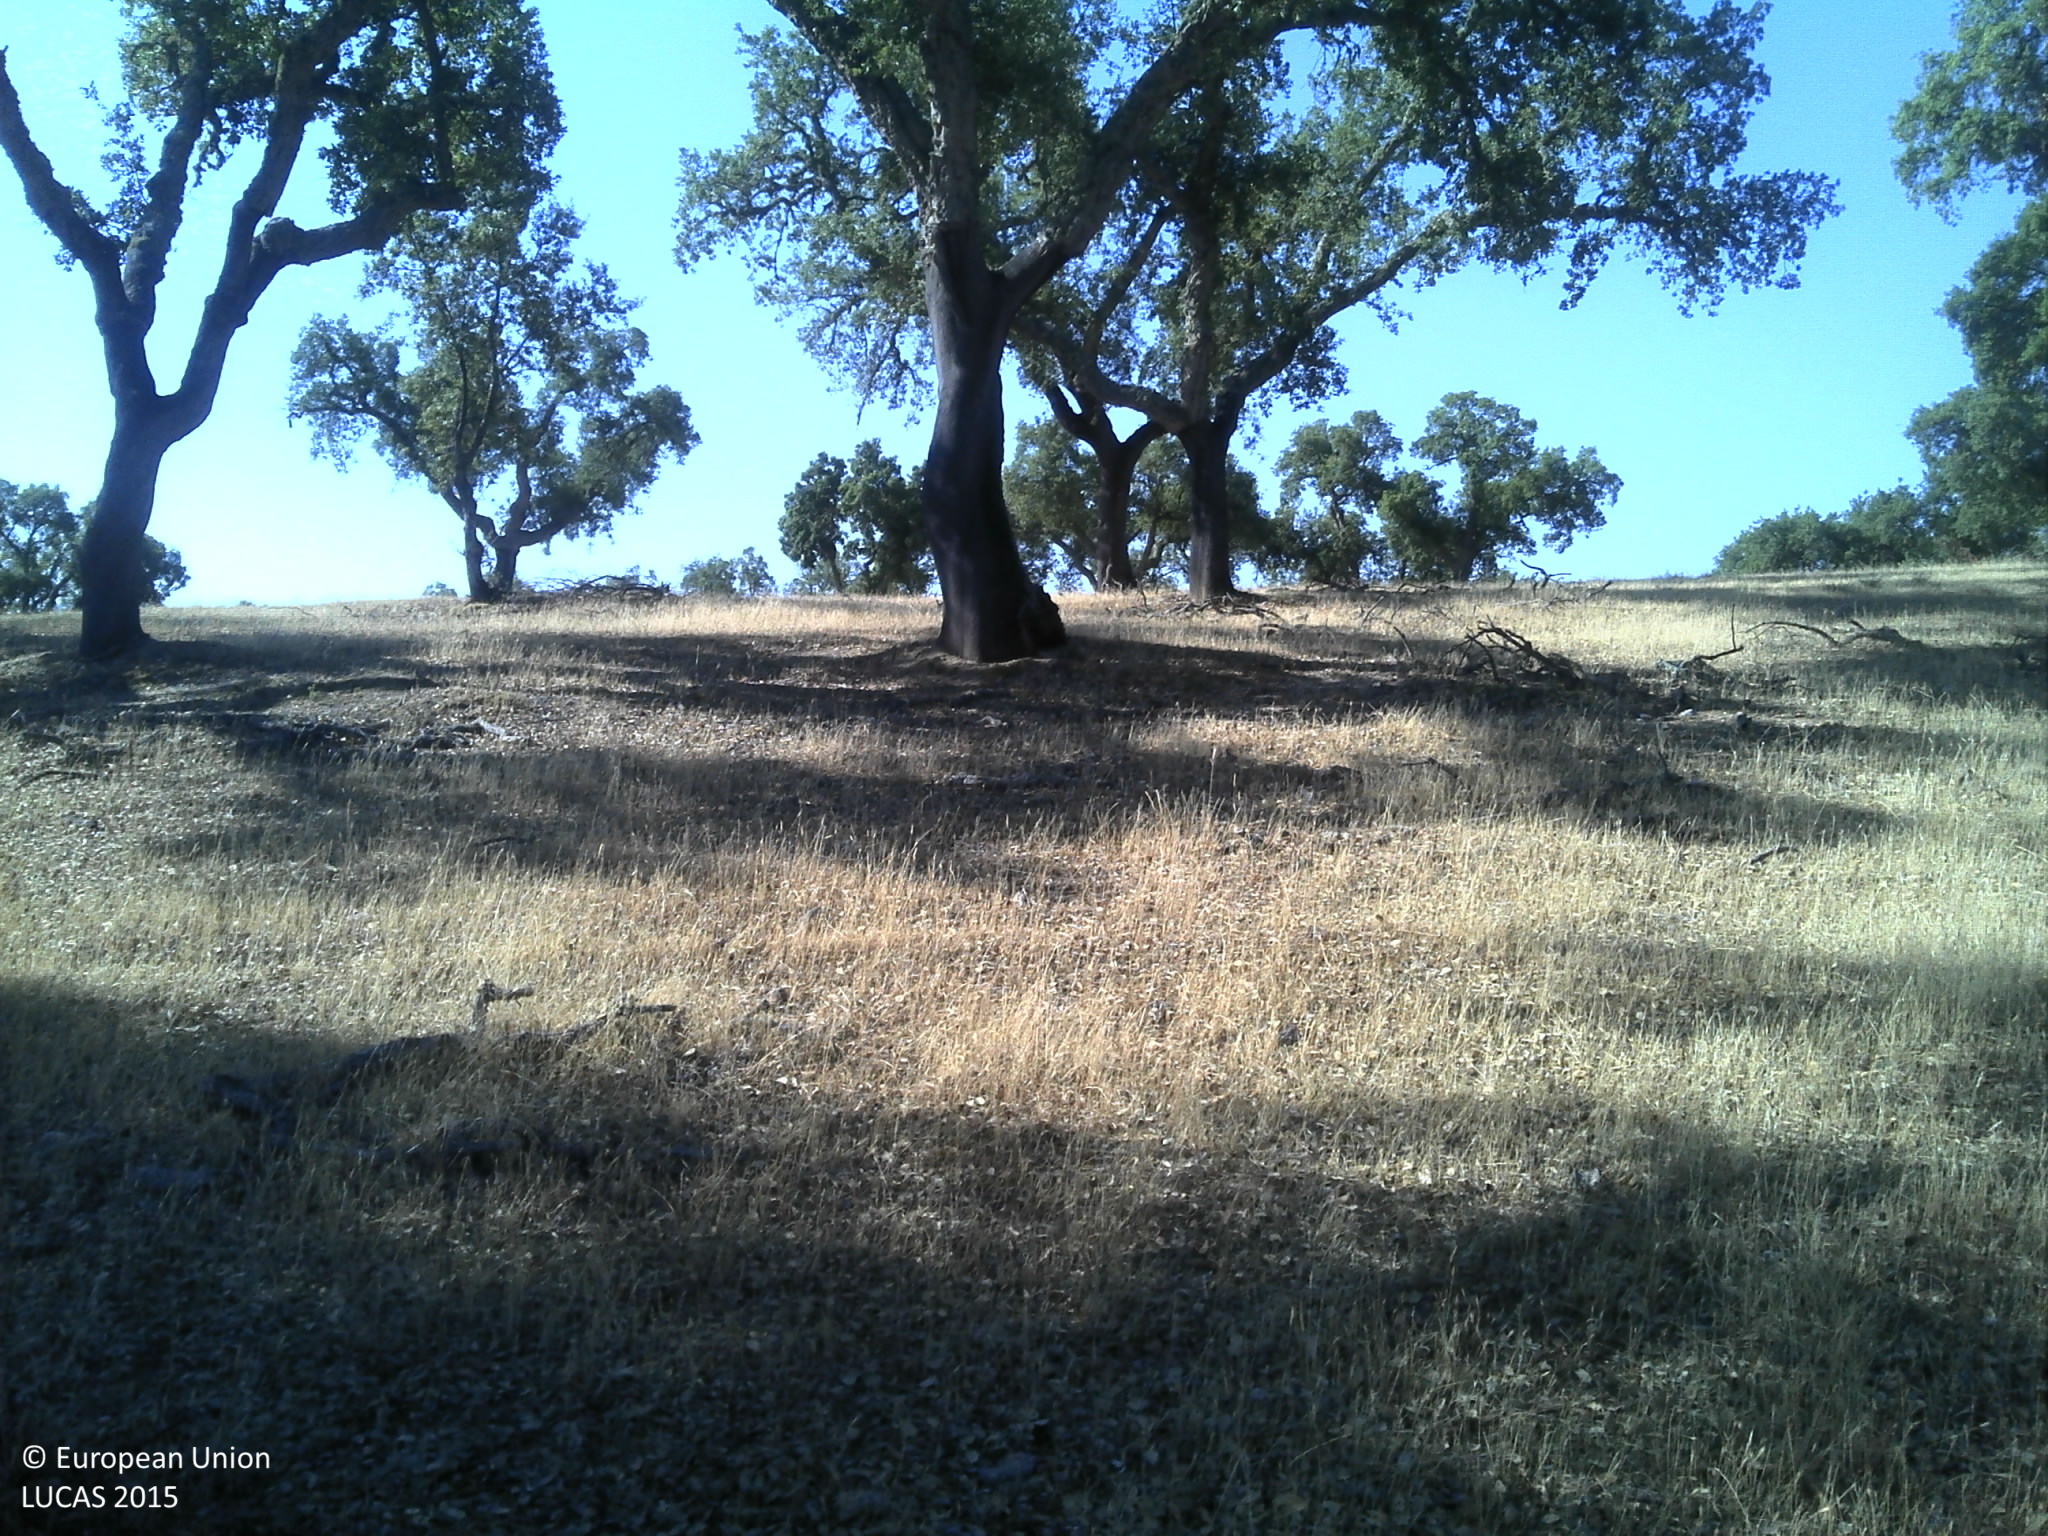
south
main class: Woodland
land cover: Broadleaved woodland
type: broadleaved evergreen forest
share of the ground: 50 - 75 %
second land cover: Grassland without tree/shrub cover
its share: 25 - 50 %
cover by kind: broadleaved forest trees 50 %, herbaceous plants 40 %, unconsolidated bare surface 10 %
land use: Forestry
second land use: Agriculture (excluding fallow land and kitchen gardens)
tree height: > 5 m
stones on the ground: 10 - 25 %
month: June
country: PT
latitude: 39.7967
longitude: -7.2487
